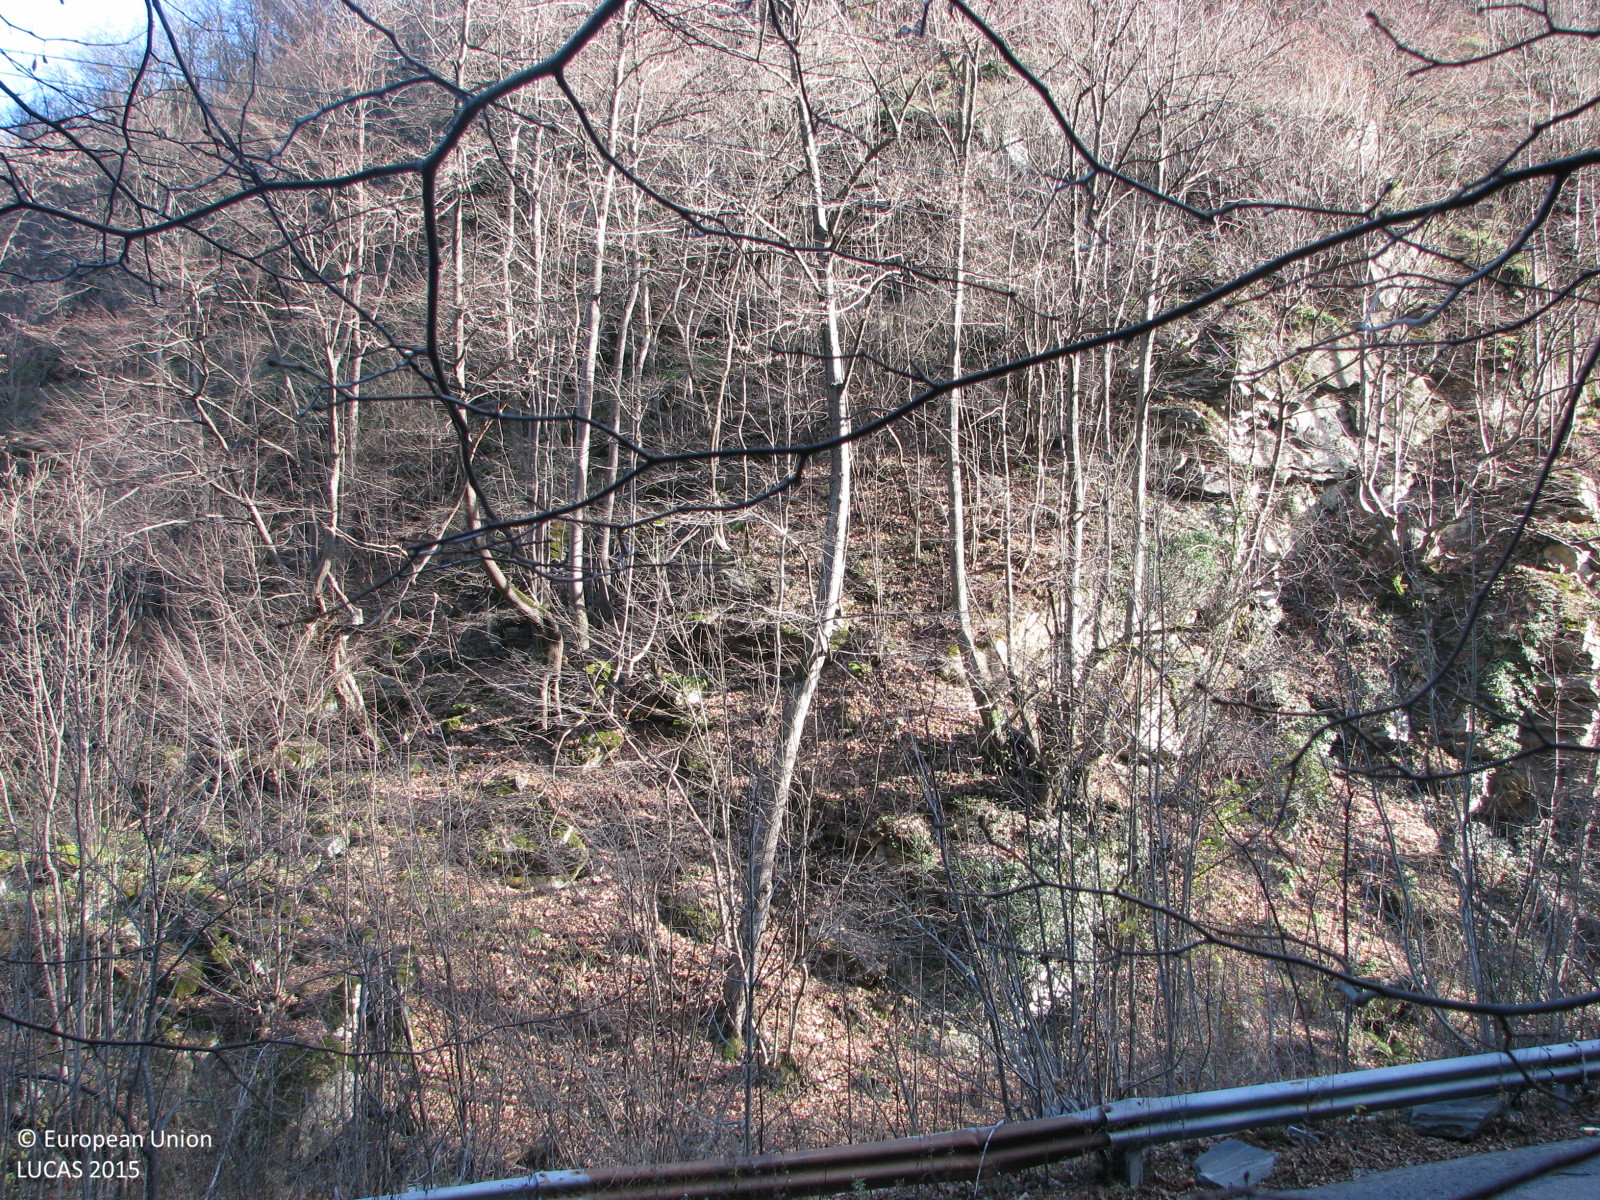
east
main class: Woodland
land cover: Broadleaved woodland
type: mesophytic deciduous forest
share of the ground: 50 - 75 %
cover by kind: broadleaved forest trees 70 %, unconsolidated bare surface 30 %
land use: Forestry
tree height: > 5 m
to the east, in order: Broadleaved woodland; Paved roads, cycling and walking lanes; Electric lines; Grassland with sparse tree/shrub cover; Inland fresh running water; Rocks and stones; Broadleaved woodland
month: December
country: BG
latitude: 42.1566
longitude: 23.9684
